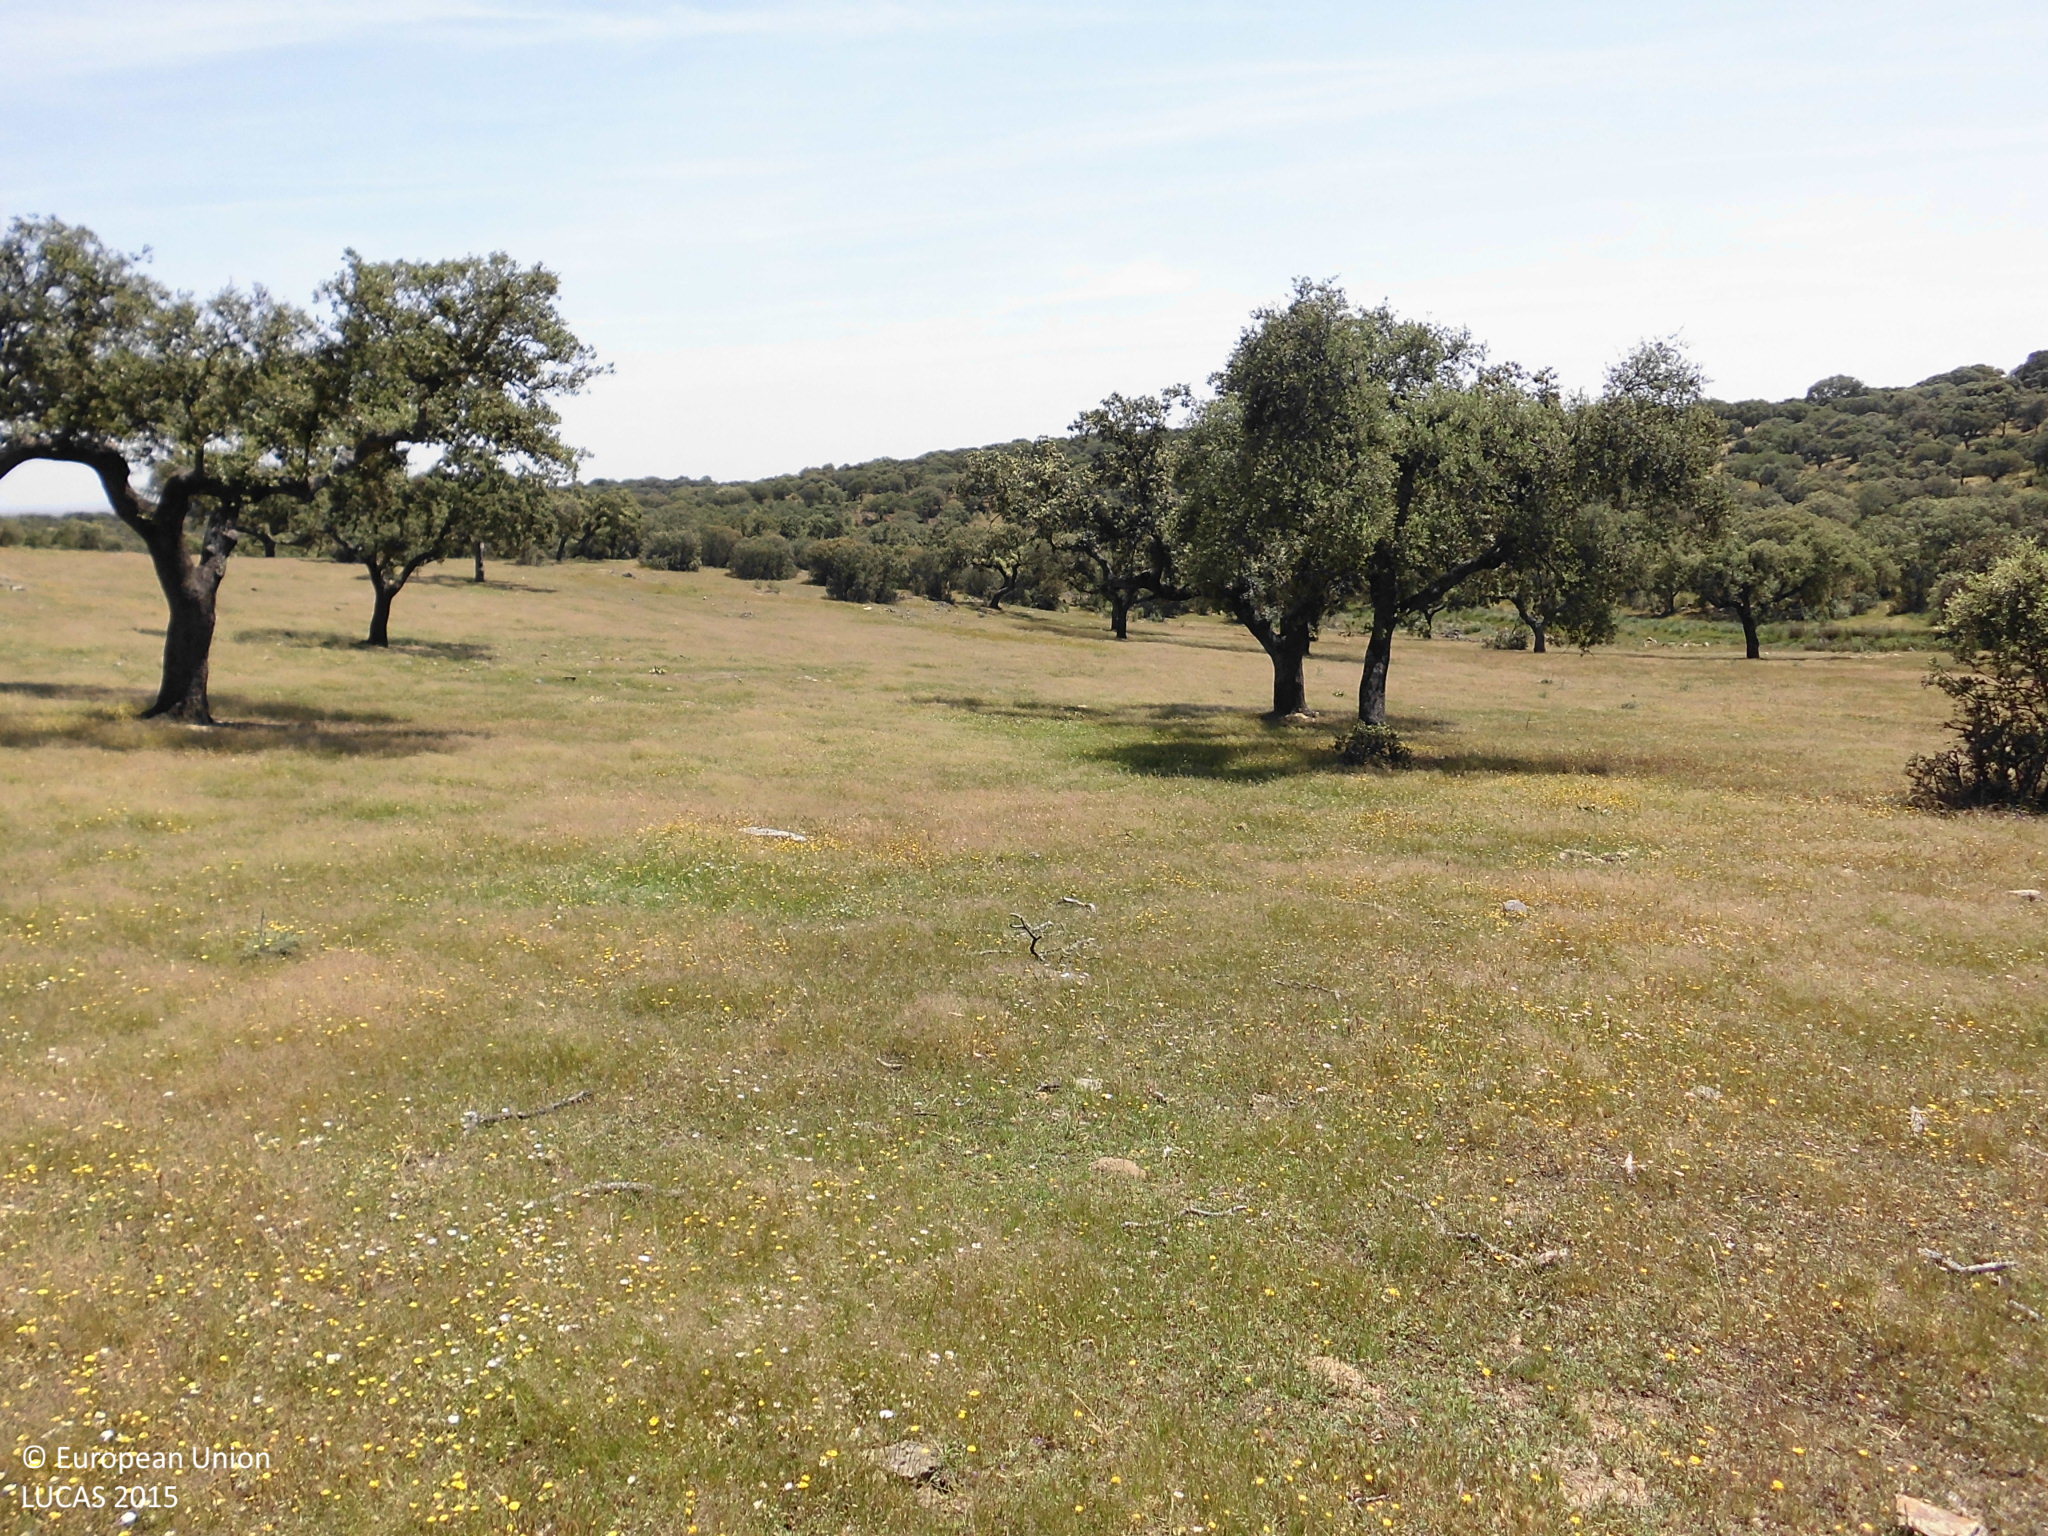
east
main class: Woodland
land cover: Broadleaved woodland
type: broadleaved evergreen forest
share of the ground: 10 - 25 %
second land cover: Grassland without tree/shrub cover
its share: > 75 %
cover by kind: herbaceous plants 85 %, broadleaved forest trees 15 %
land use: Forestry
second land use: Agriculture (excluding fallow land and kitchen gardens)
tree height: > 5 m
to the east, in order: Broadleaved woodland; Grassland without tree/shrub cover; Broadleaved woodland
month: May
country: ES
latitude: 39.4786
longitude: -7.0676
